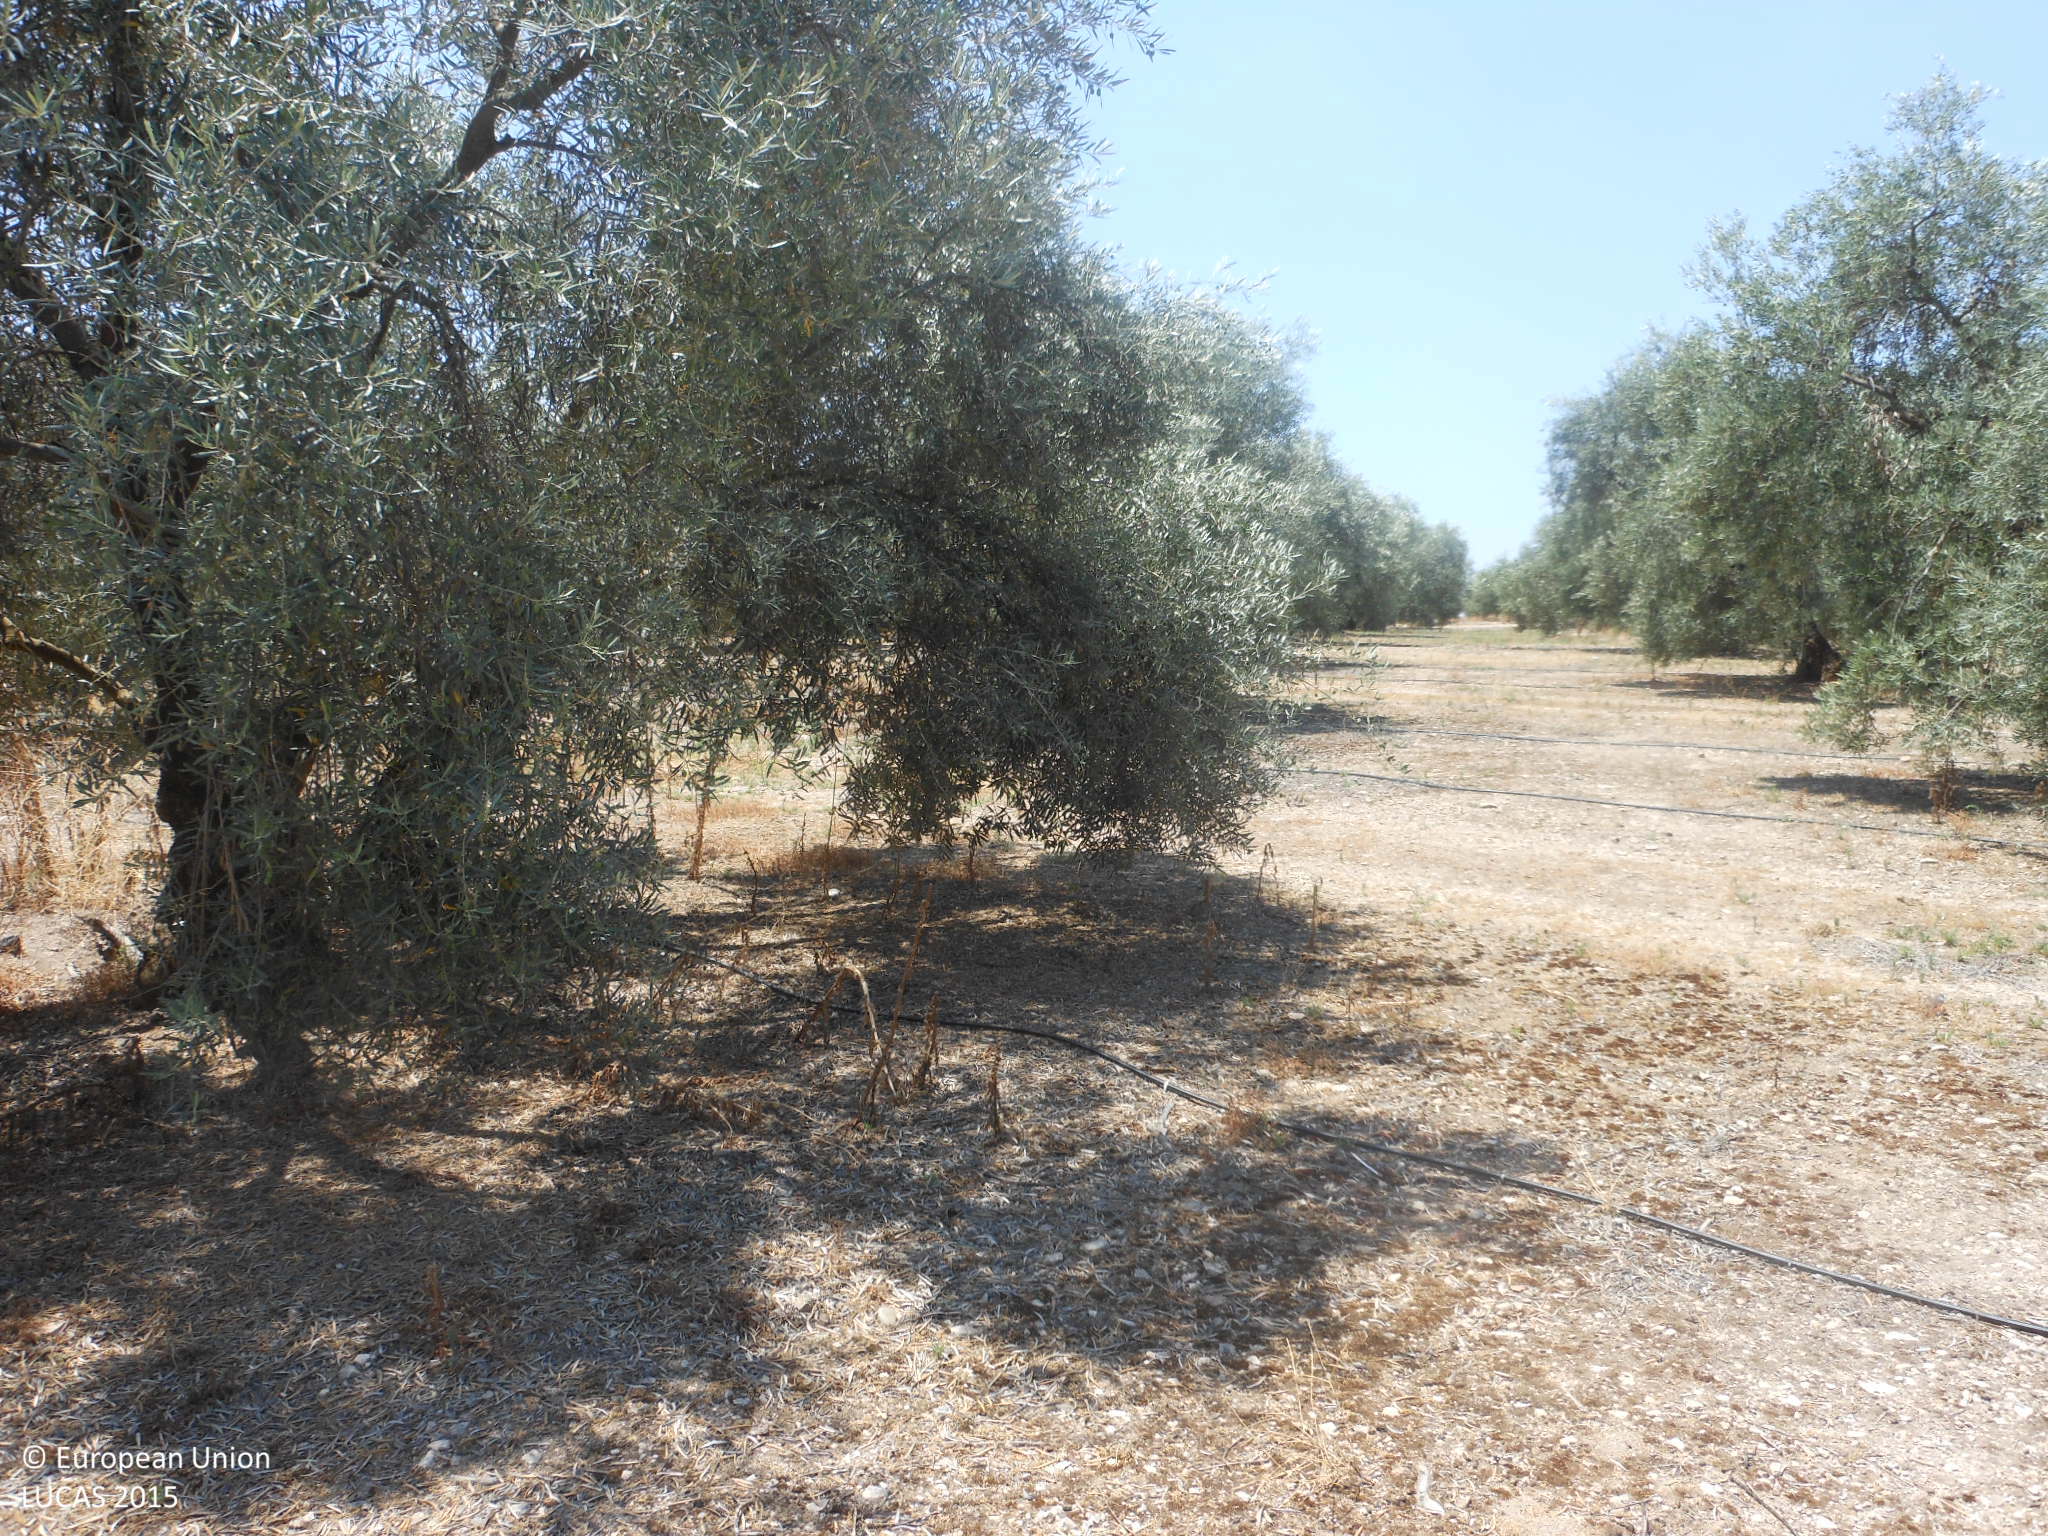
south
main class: Cropland
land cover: Olive groves
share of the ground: 50 - 75 %
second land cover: Other bare soil
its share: > 75 %
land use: Agriculture (excluding fallow land and kitchen gardens)
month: June
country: ES
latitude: 37.3971
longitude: -4.8843
